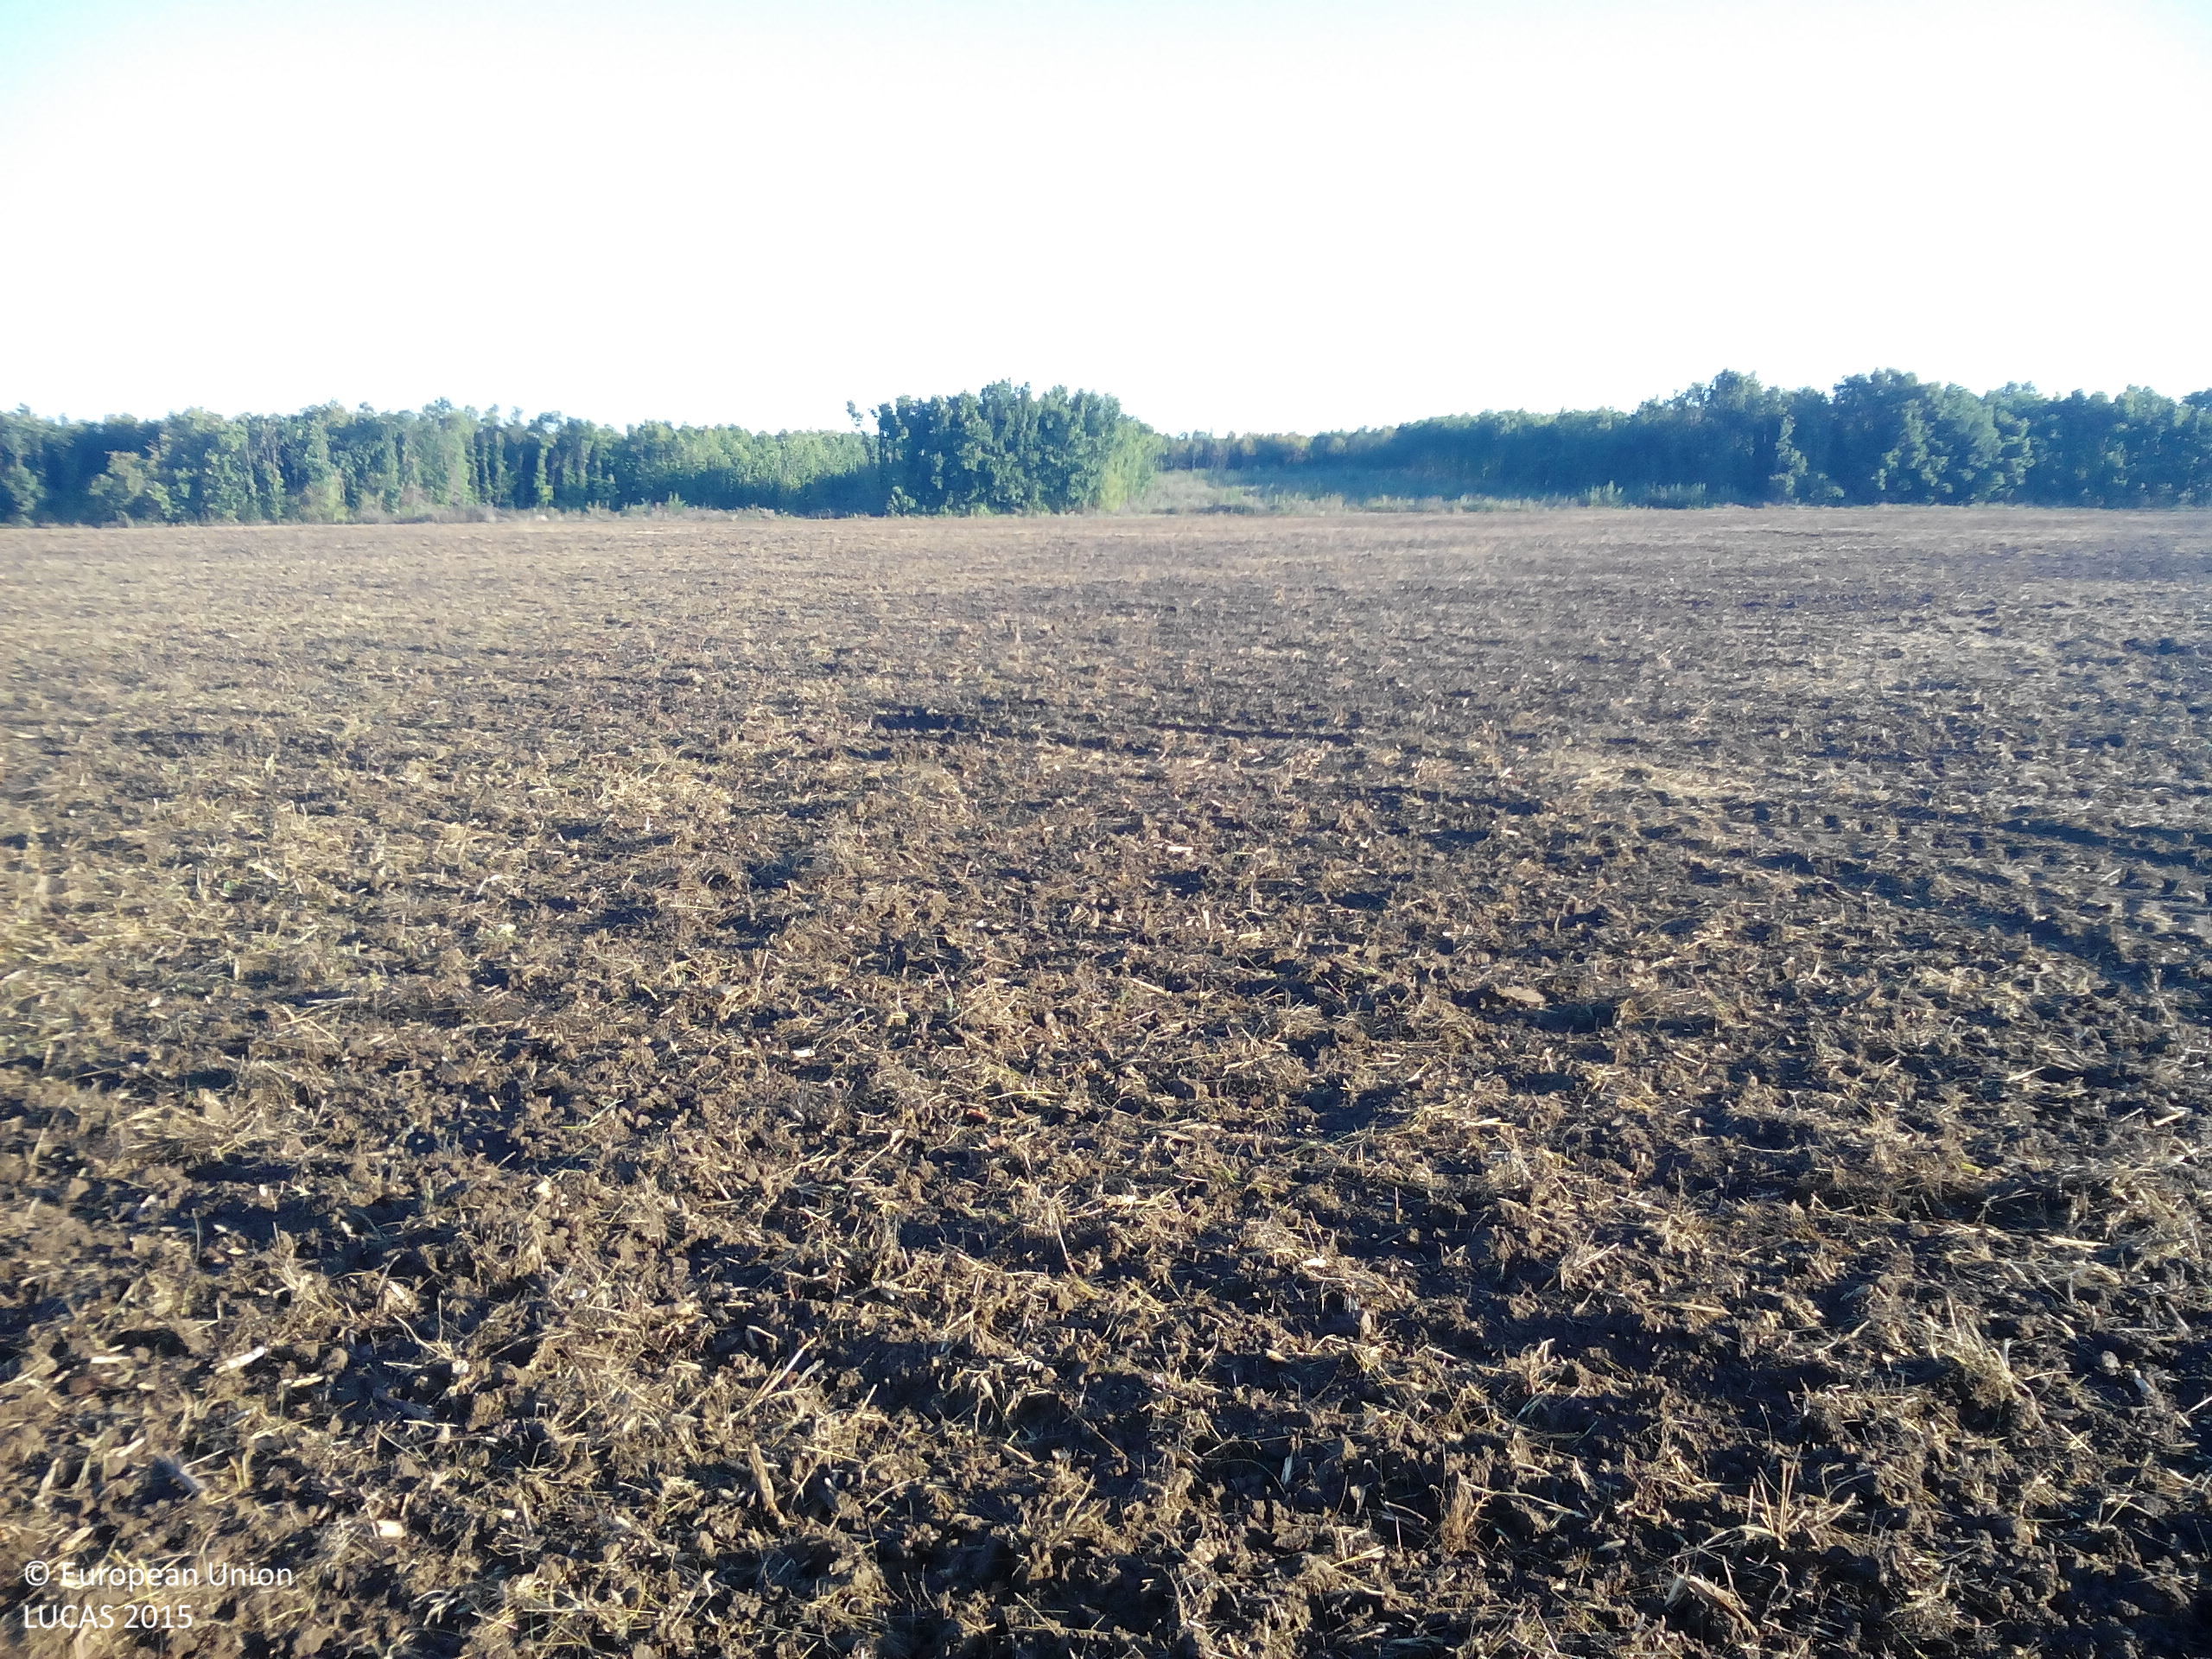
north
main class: Cropland
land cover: Maize
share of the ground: < 10 %
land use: Agriculture (excluding fallow land and kitchen gardens)
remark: Harvested field
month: October
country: BG
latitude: 43.3465
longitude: 23.8280
